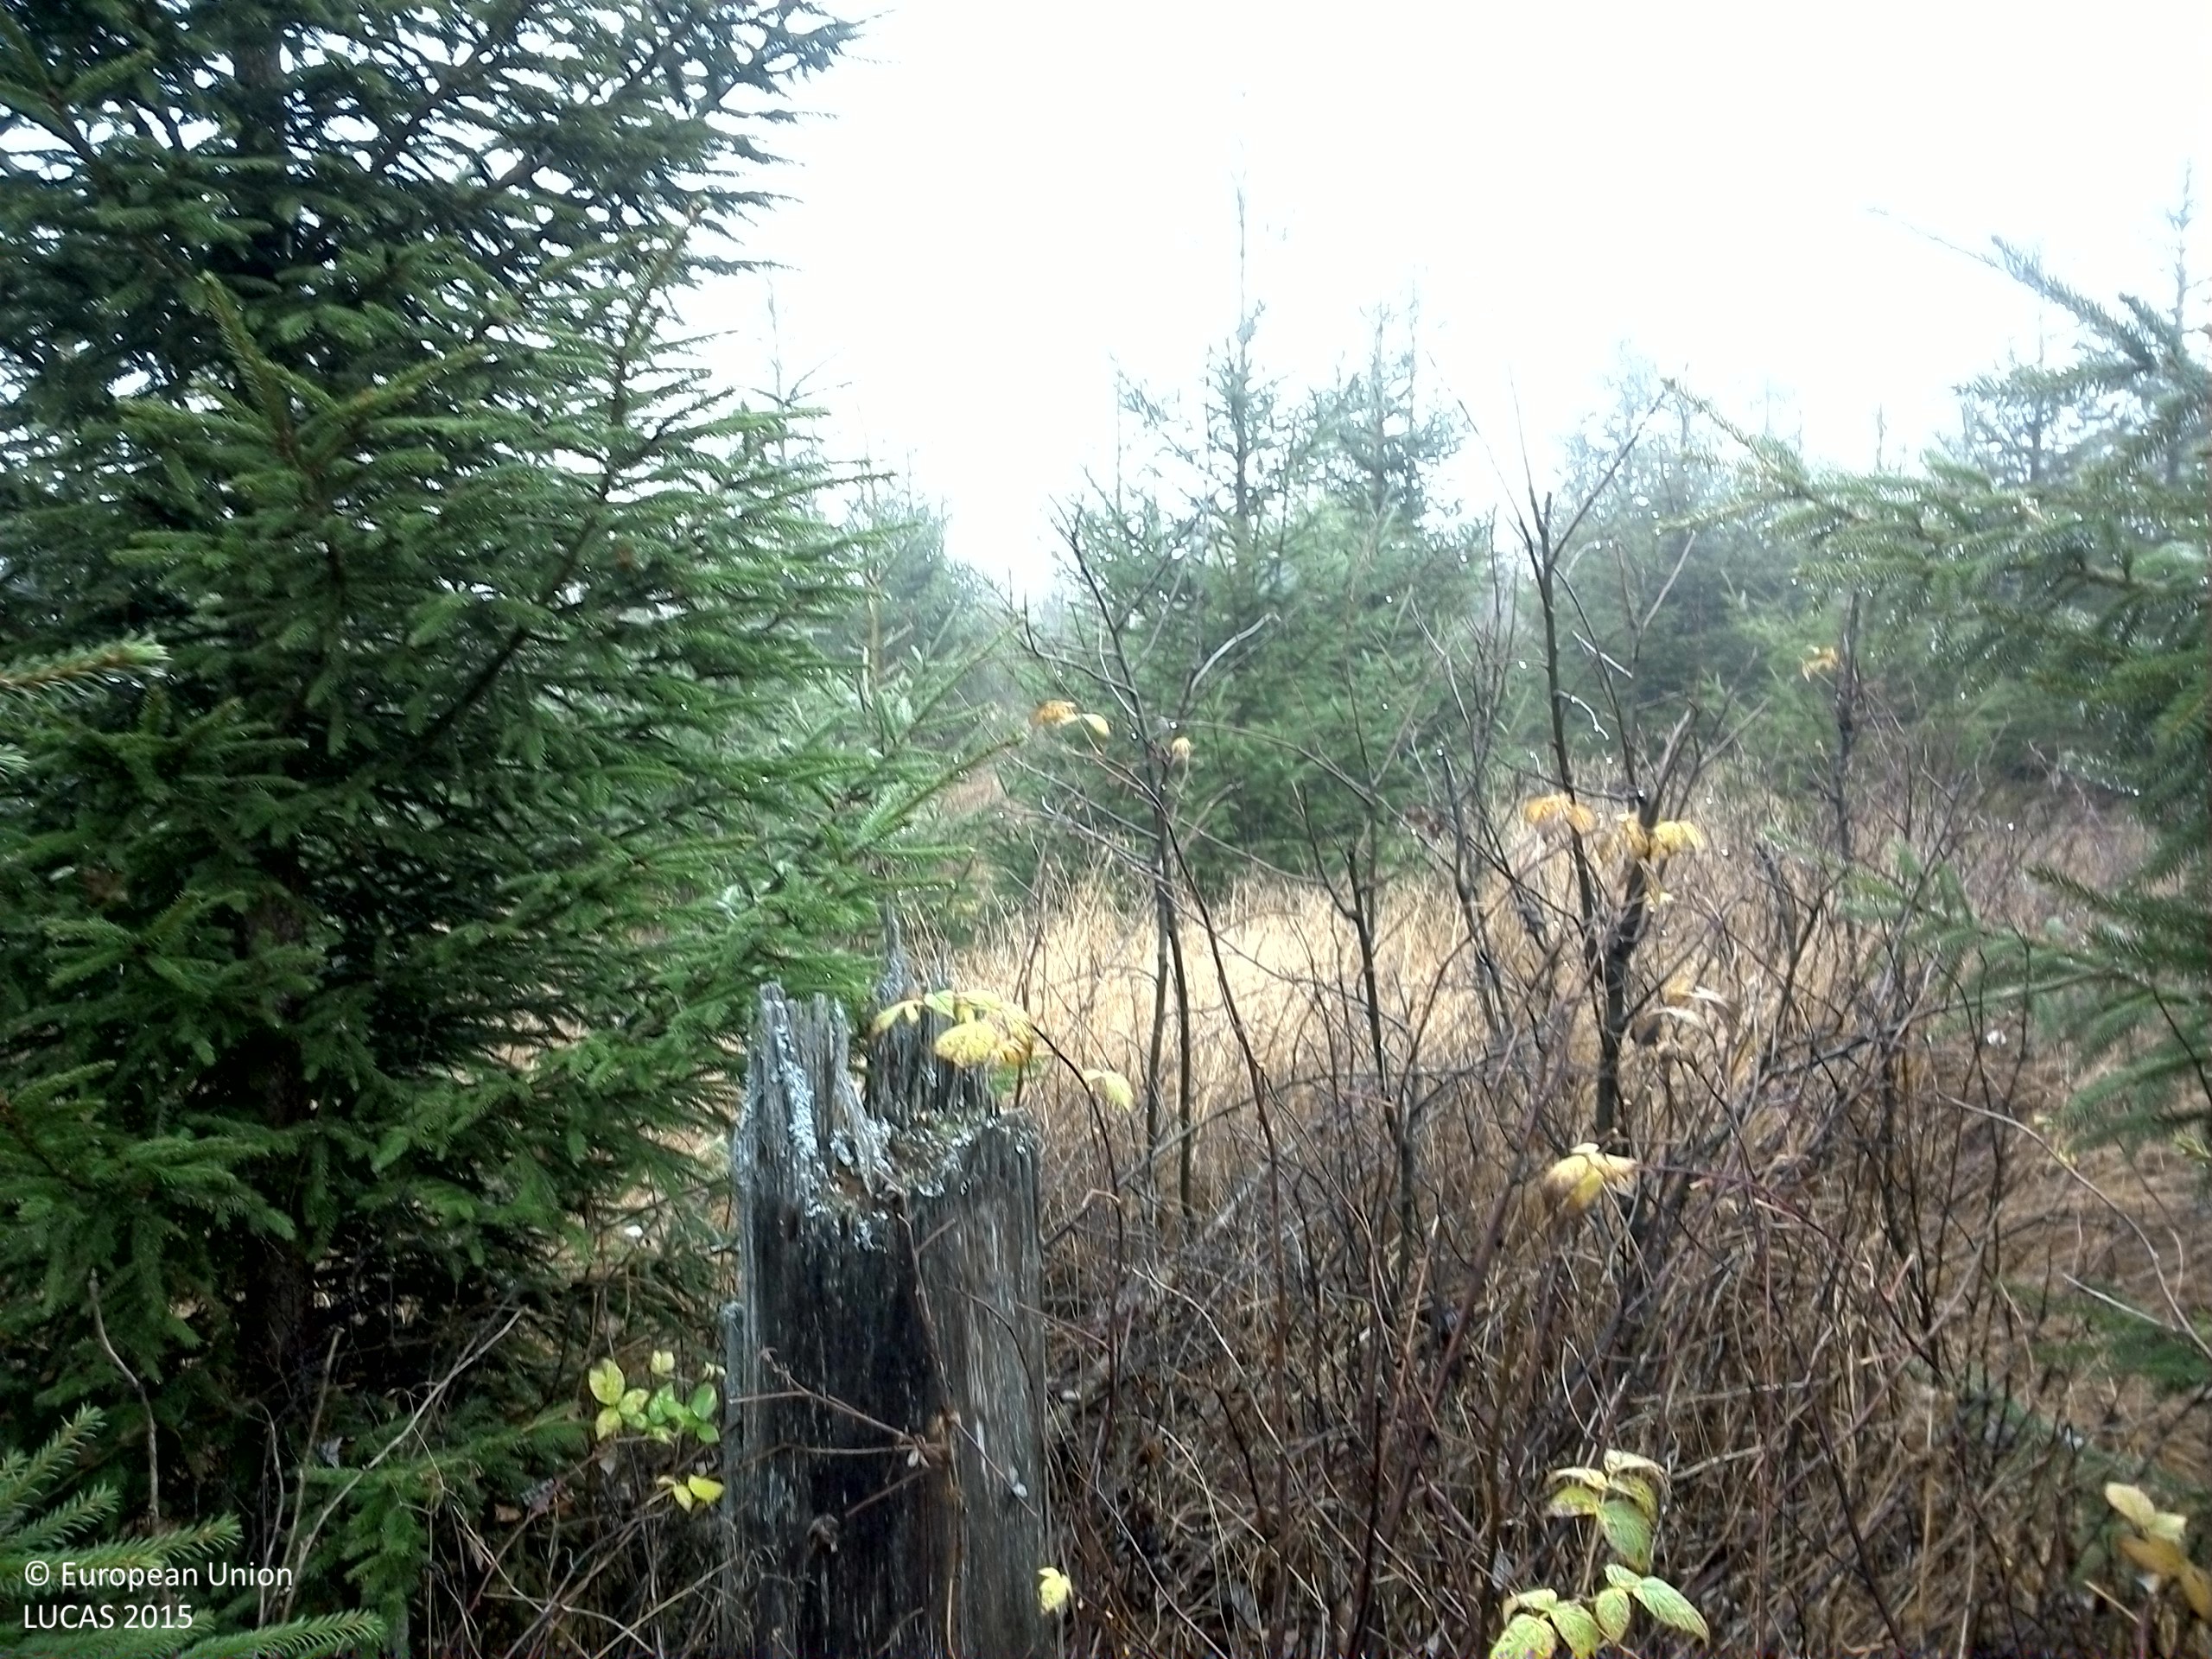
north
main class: Woodland
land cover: Spruce dominated mixed woodland
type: boreal forest
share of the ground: 50 - 75 %
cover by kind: coniferous forest trees 45 %, broadleaved forest trees 25 %, shrubs 15 %, herbaceous plants 15 %
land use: Forestry
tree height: < 5 m
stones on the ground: < 10 %
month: November
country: SE
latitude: 57.9150
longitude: 14.8731
